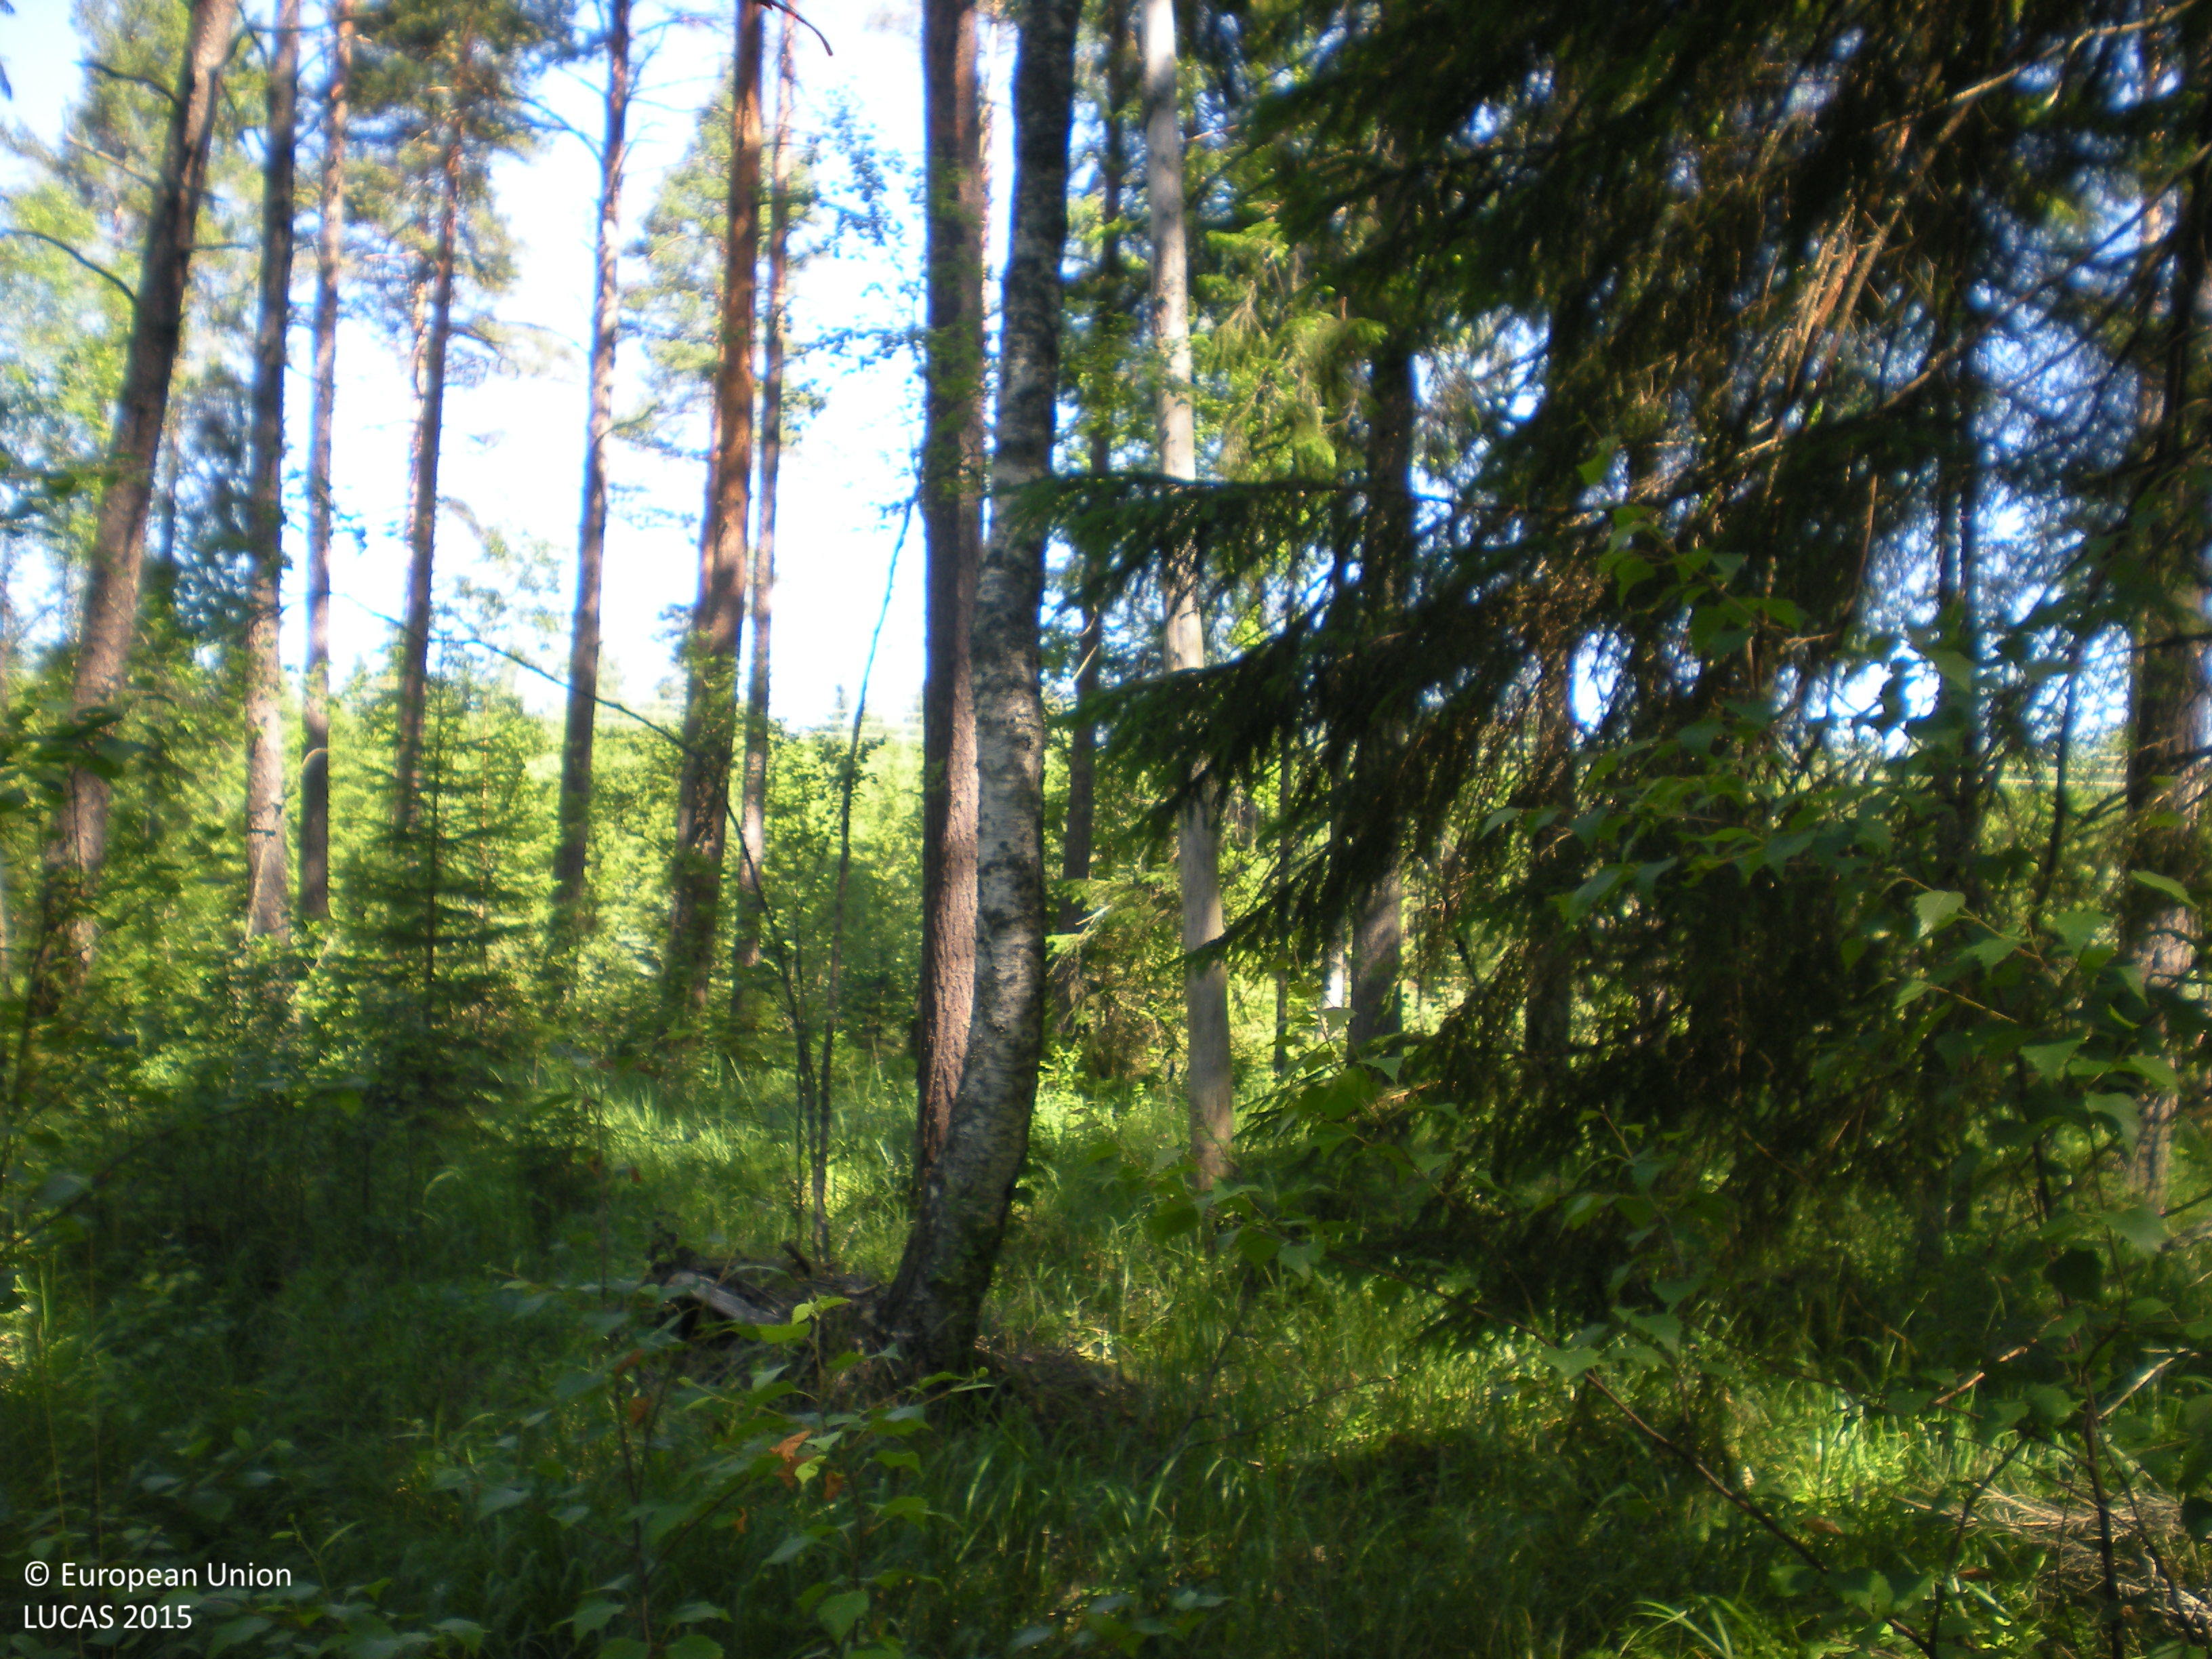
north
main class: Woodland
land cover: Other mixed woodland
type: boreal forest
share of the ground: 50 - 75 %
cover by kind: coniferous forest trees 60 %, broadleaved forest trees 20 %, herbaceous plants 15 %, lichens and mosses 5 %
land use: Forestry
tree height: > 5 m
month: July
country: SE
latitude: 60.4718
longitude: 17.7954
